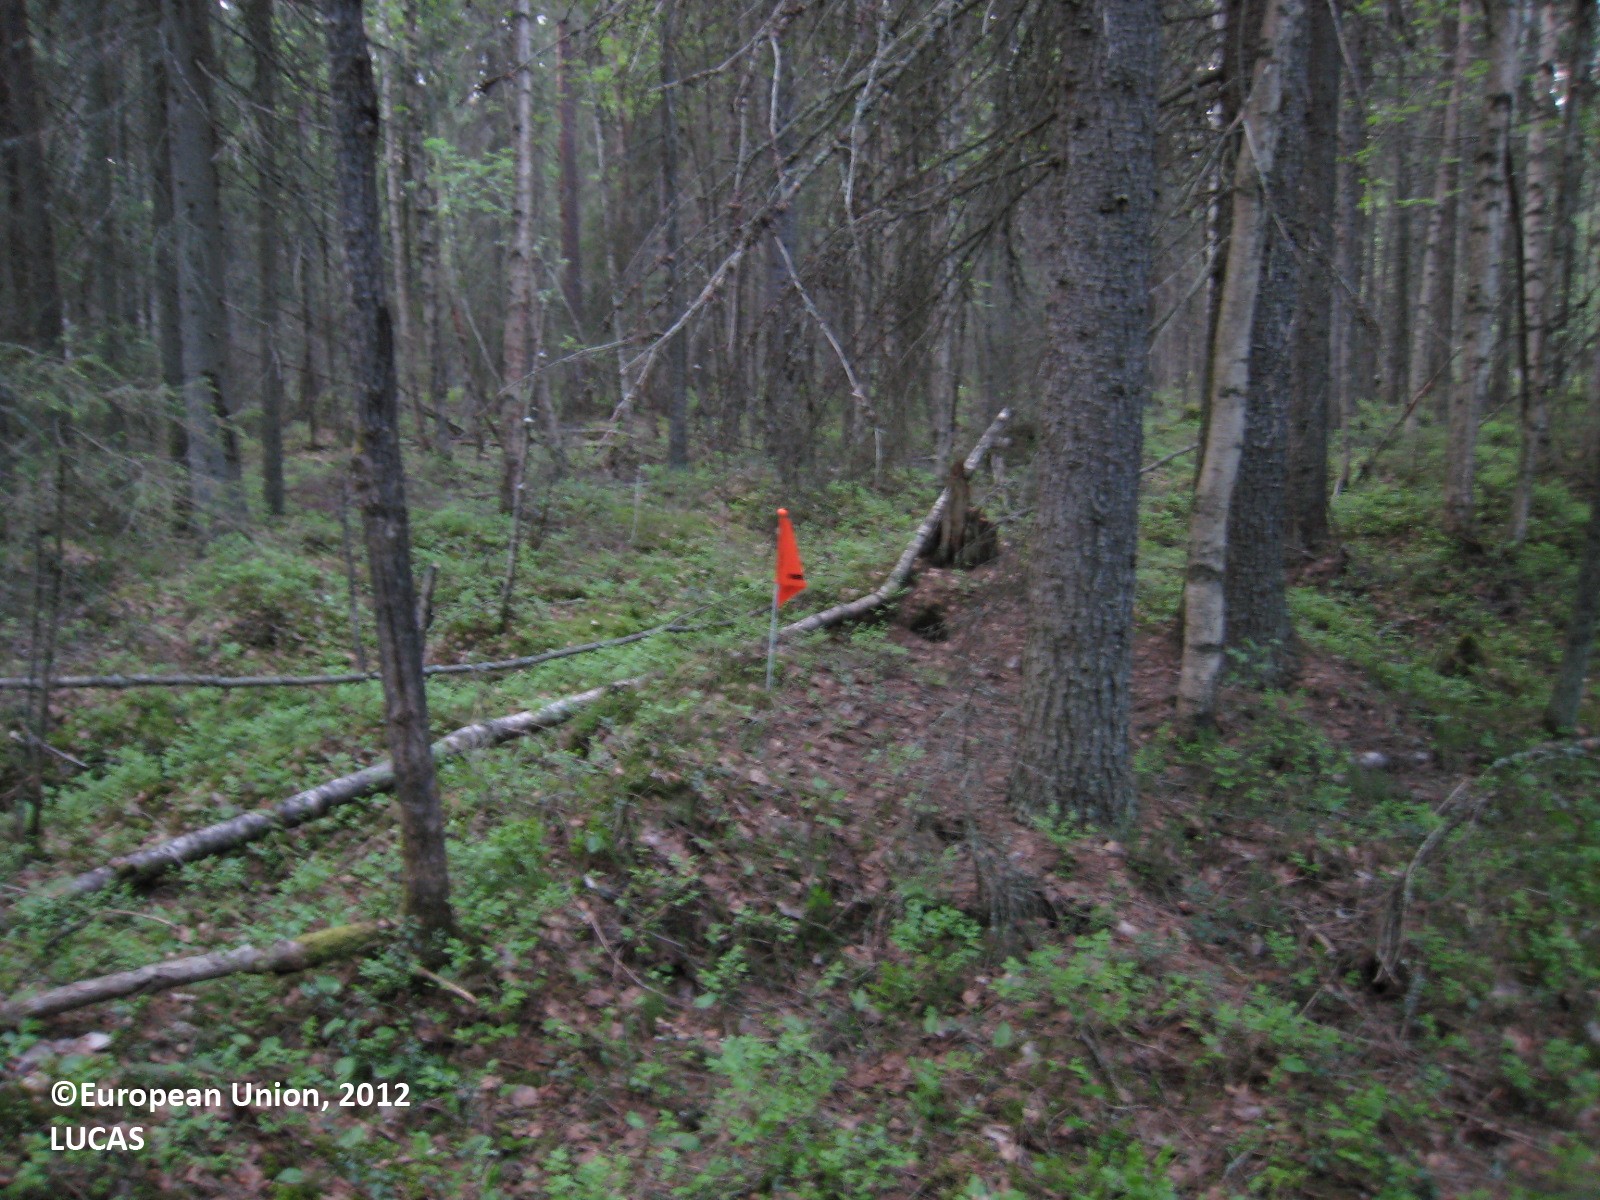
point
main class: Woodland
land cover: Spruce dominated mixed woodland
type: boreal forest
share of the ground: > 75 %
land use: Forestry
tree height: > 5 m
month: June
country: FI
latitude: 62.5686
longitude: 26.1005
